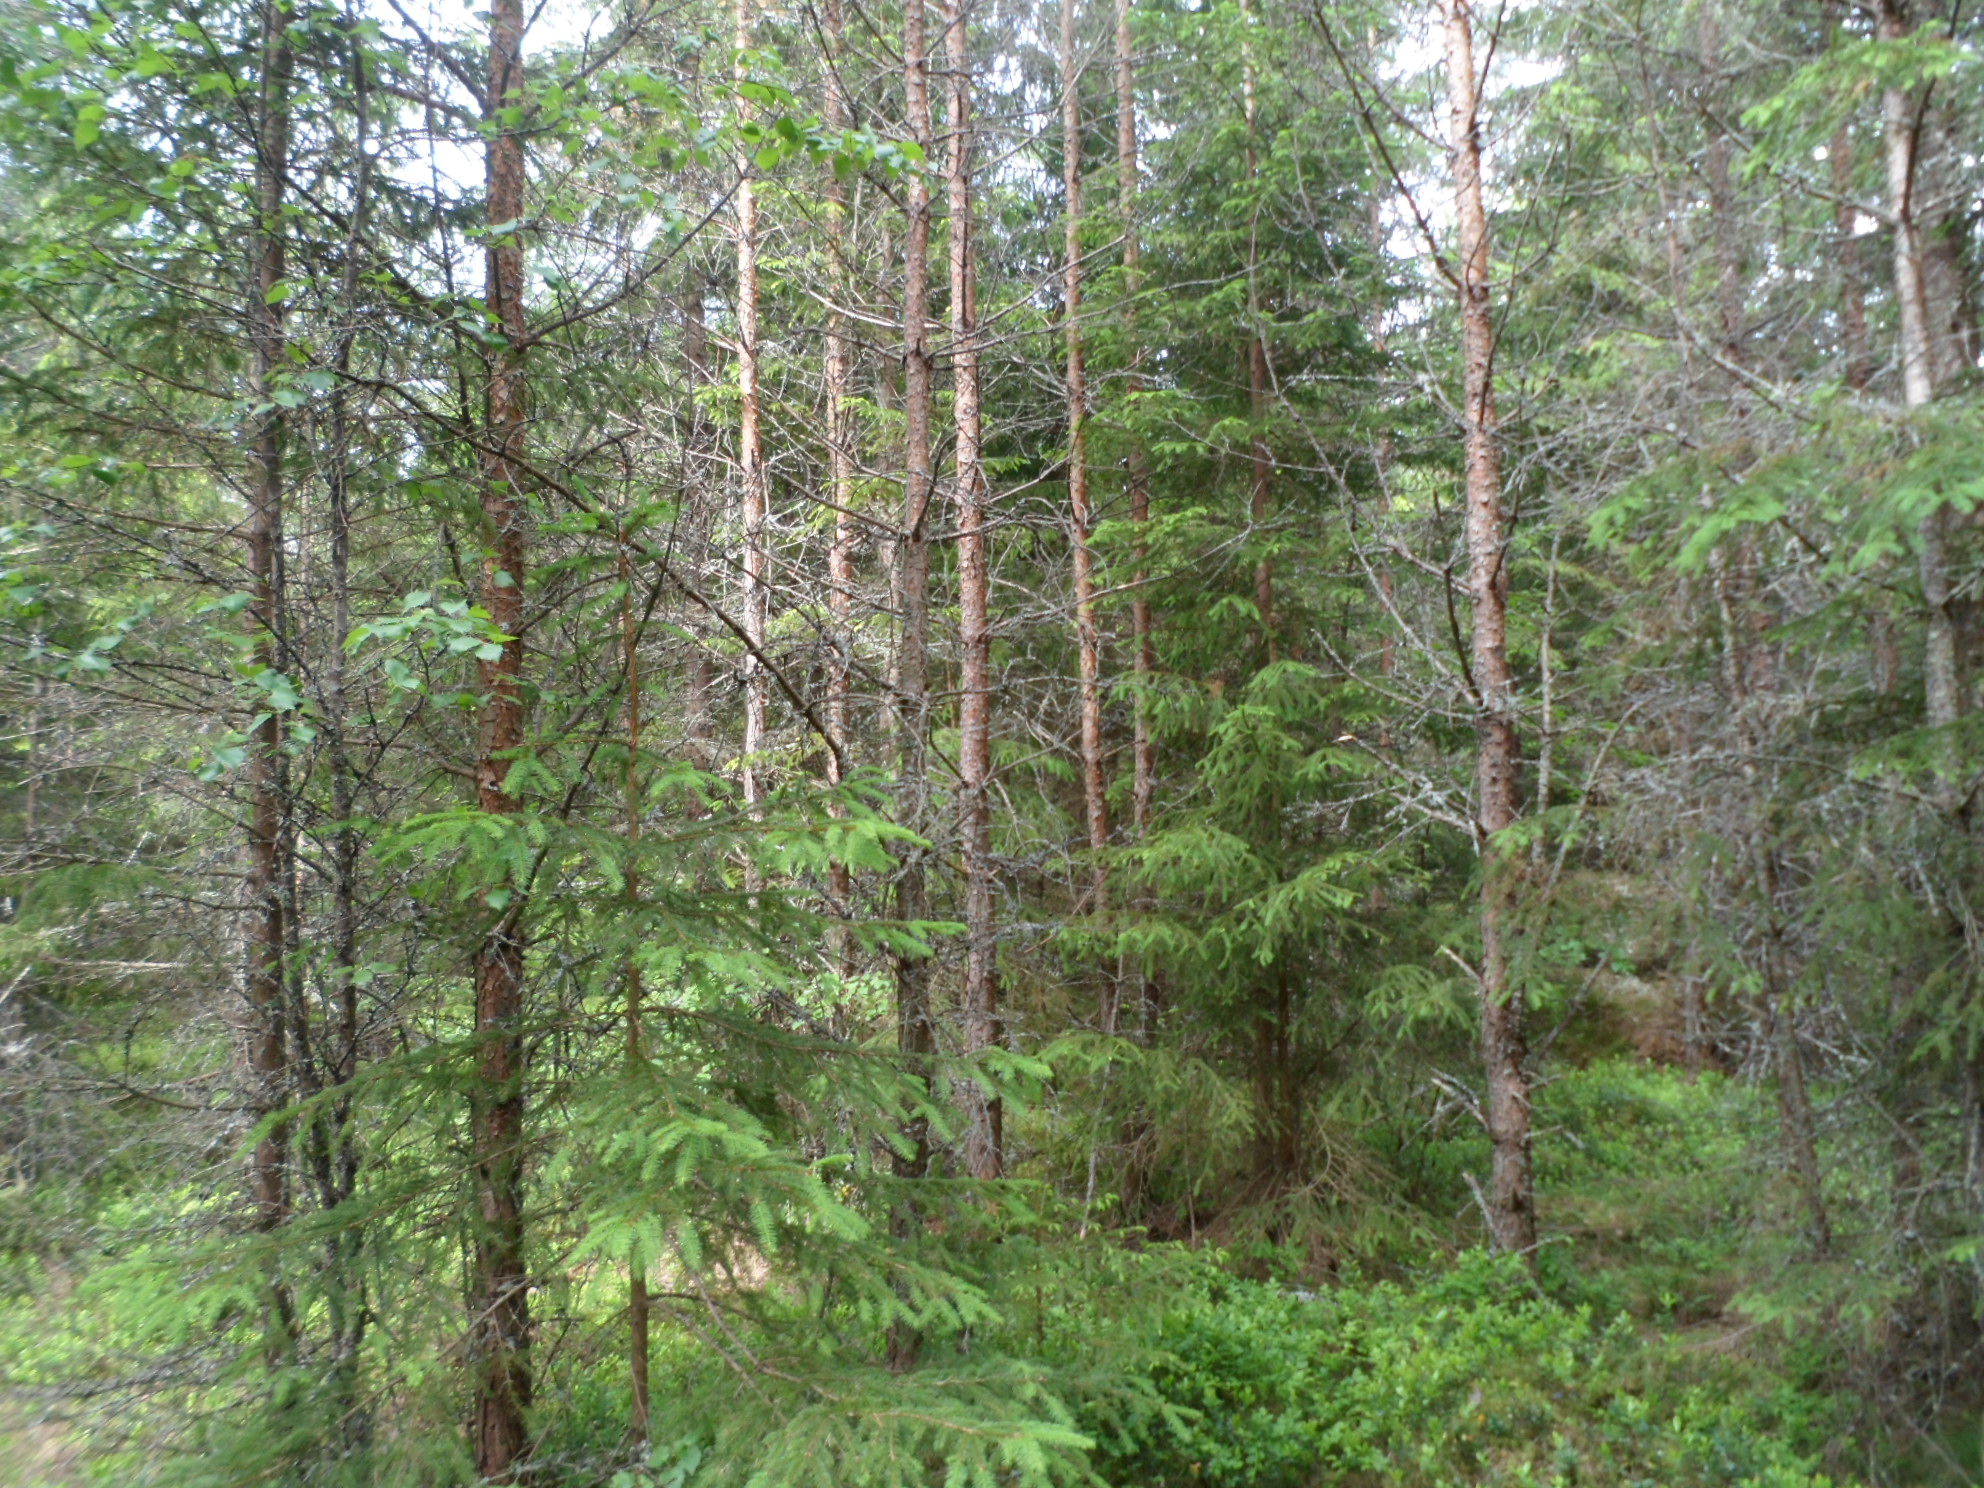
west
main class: Woodland
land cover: Pine dominated coniferous woodland
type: boreal forest
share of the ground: 50 - 75 %
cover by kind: coniferous forest trees 70 %, shrubs 15 %, lichens and mosses 10 %, herbaceous plants 5 %
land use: Forestry
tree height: > 5 m
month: June
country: SE
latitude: 57.0161
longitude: 15.2843
